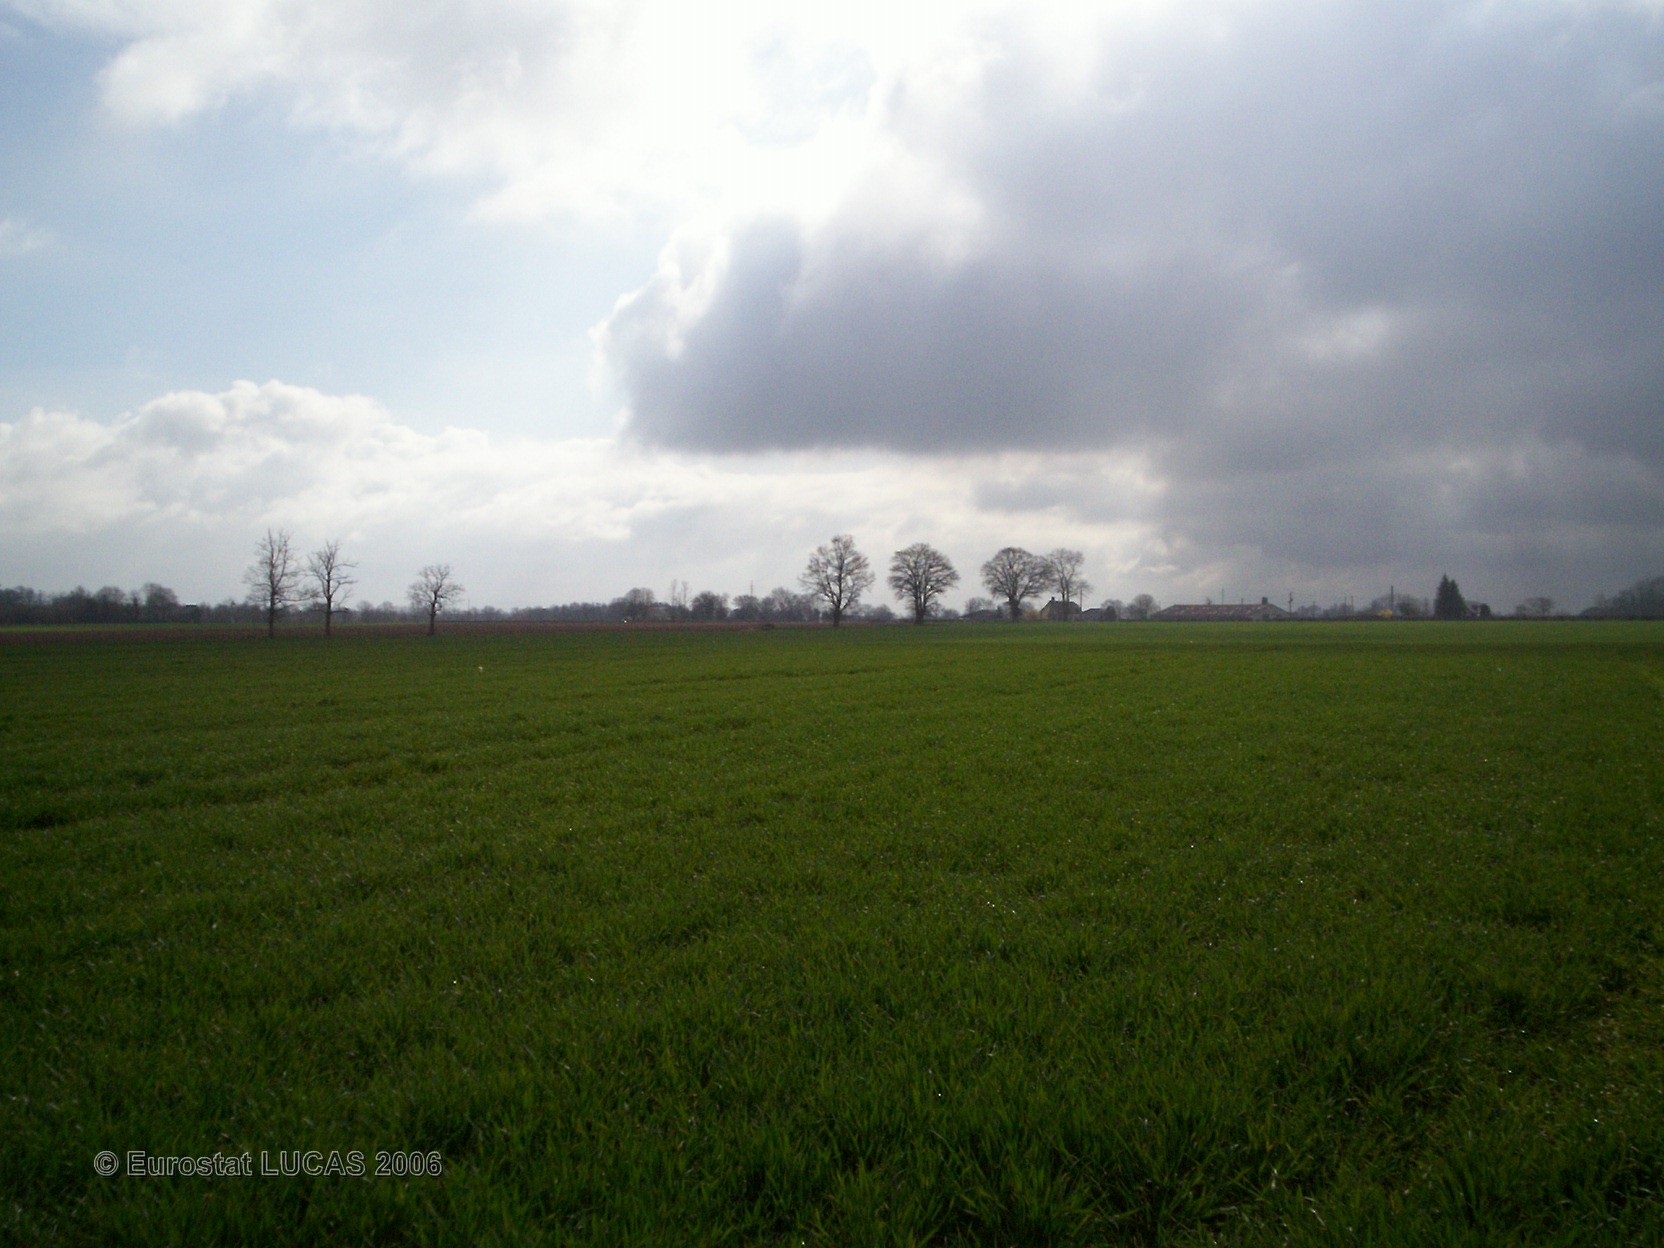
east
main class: Cropland
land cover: Triticale
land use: Agriculture (excluding fallow land and kitchen gardens)
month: April
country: FR
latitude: 48.8321
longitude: 0.5615
